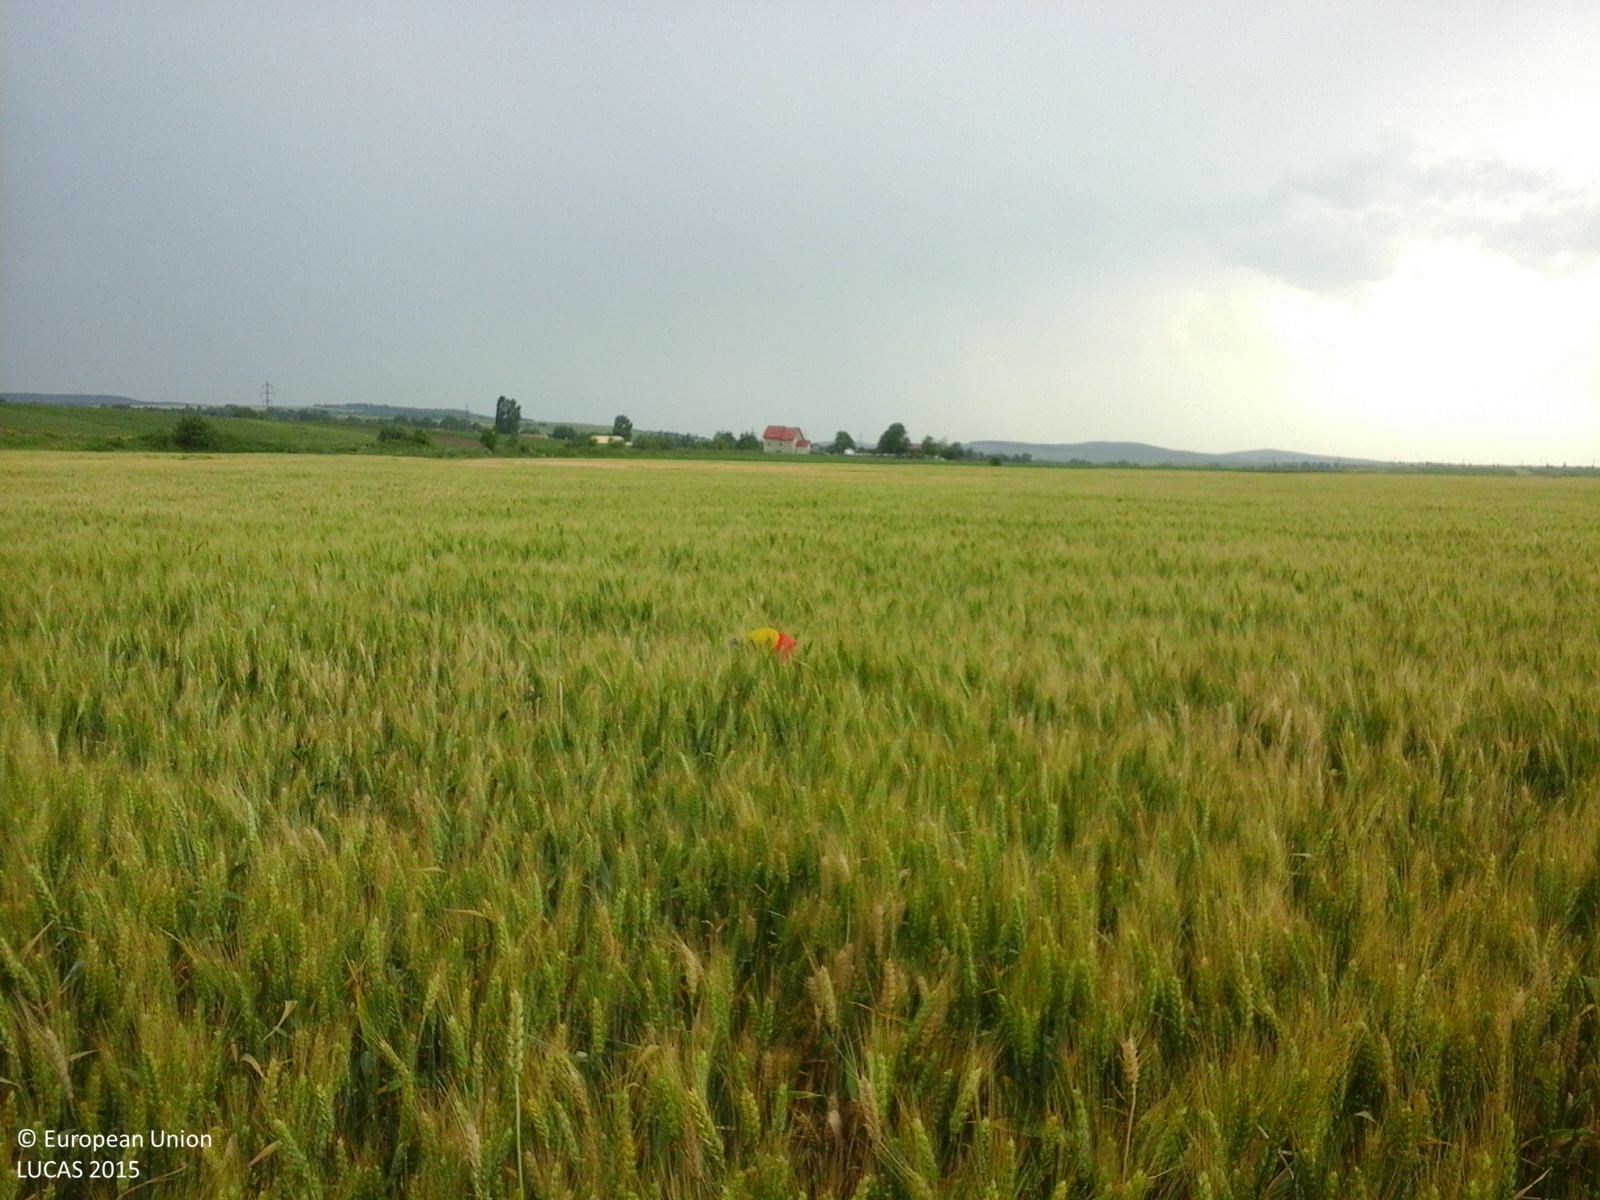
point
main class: Cropland
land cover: Common wheat
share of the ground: > 75 %
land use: Agriculture (excluding fallow land and kitchen gardens)
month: June
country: RO
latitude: 47.2887
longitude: 26.6868
